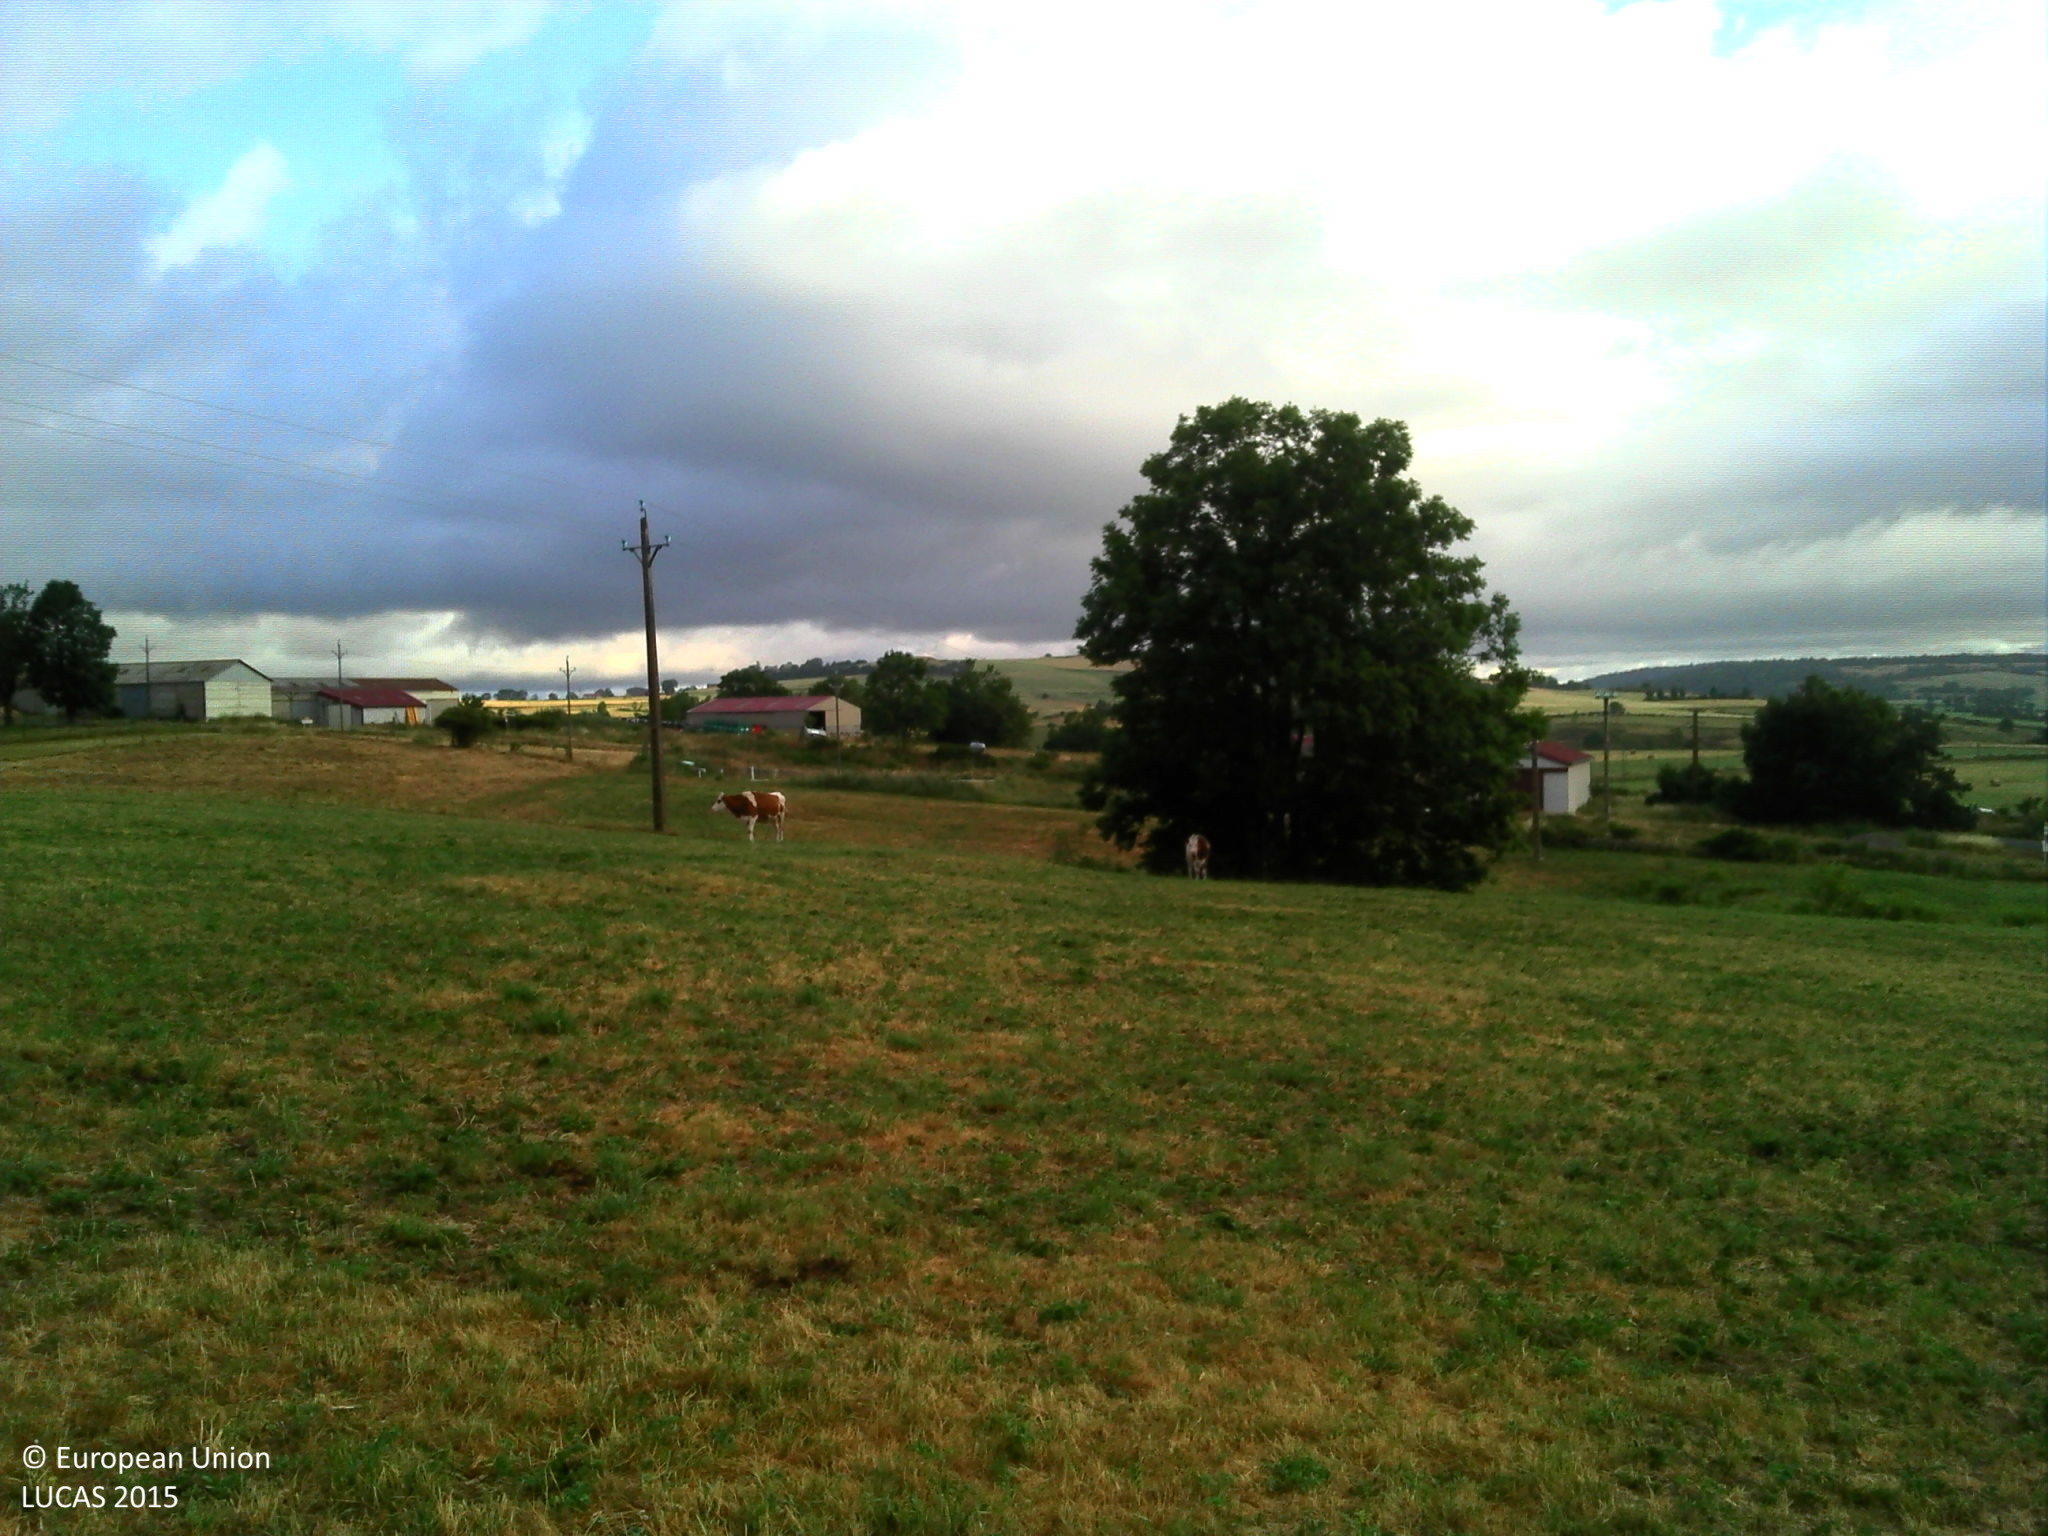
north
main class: Grassland
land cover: Grassland without tree/shrub cover
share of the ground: > 75 %
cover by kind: herbaceous plants 100 %
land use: Agriculture (excluding fallow land and kitchen gardens)
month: July
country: FR
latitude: 45.0686
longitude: 3.2074
